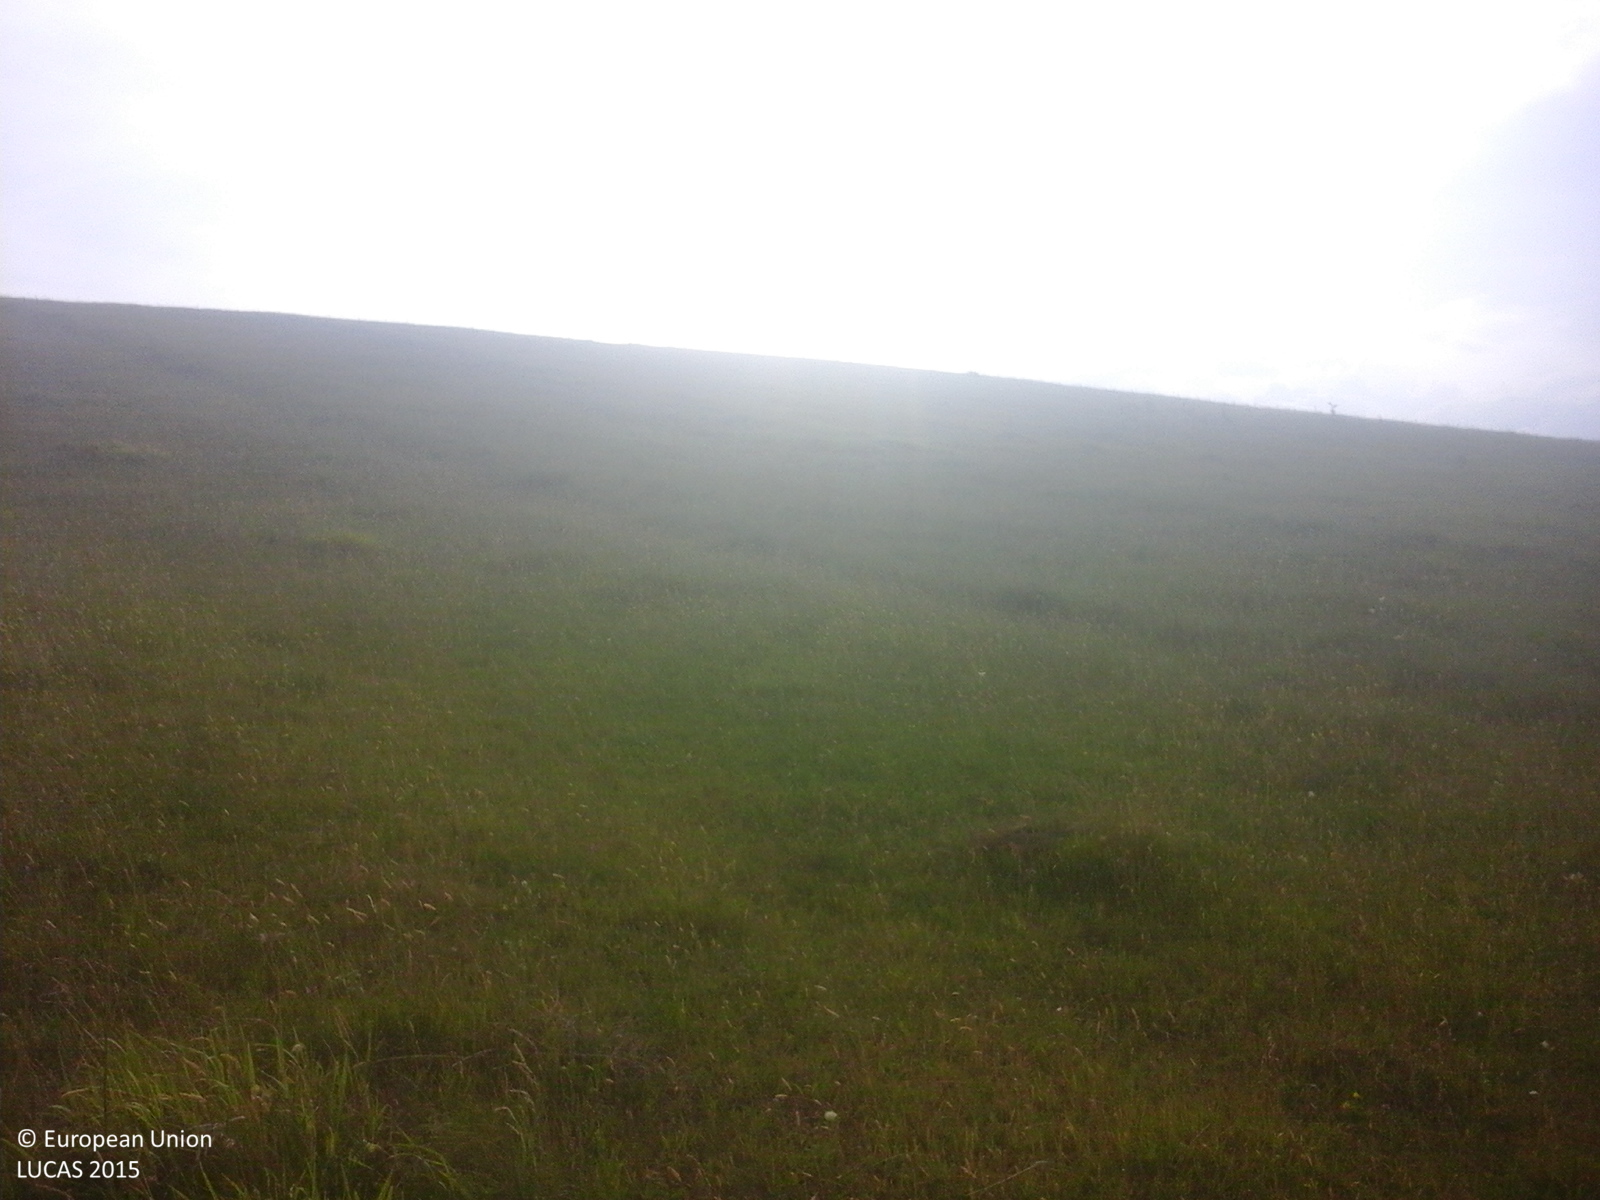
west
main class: Grassland
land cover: Grassland without tree/shrub cover
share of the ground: > 75 %
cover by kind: herbaceous plants 100 %
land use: Agriculture (excluding fallow land and kitchen gardens)
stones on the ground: < 10 %
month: June
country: RO
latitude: 46.9669
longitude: 26.3929
